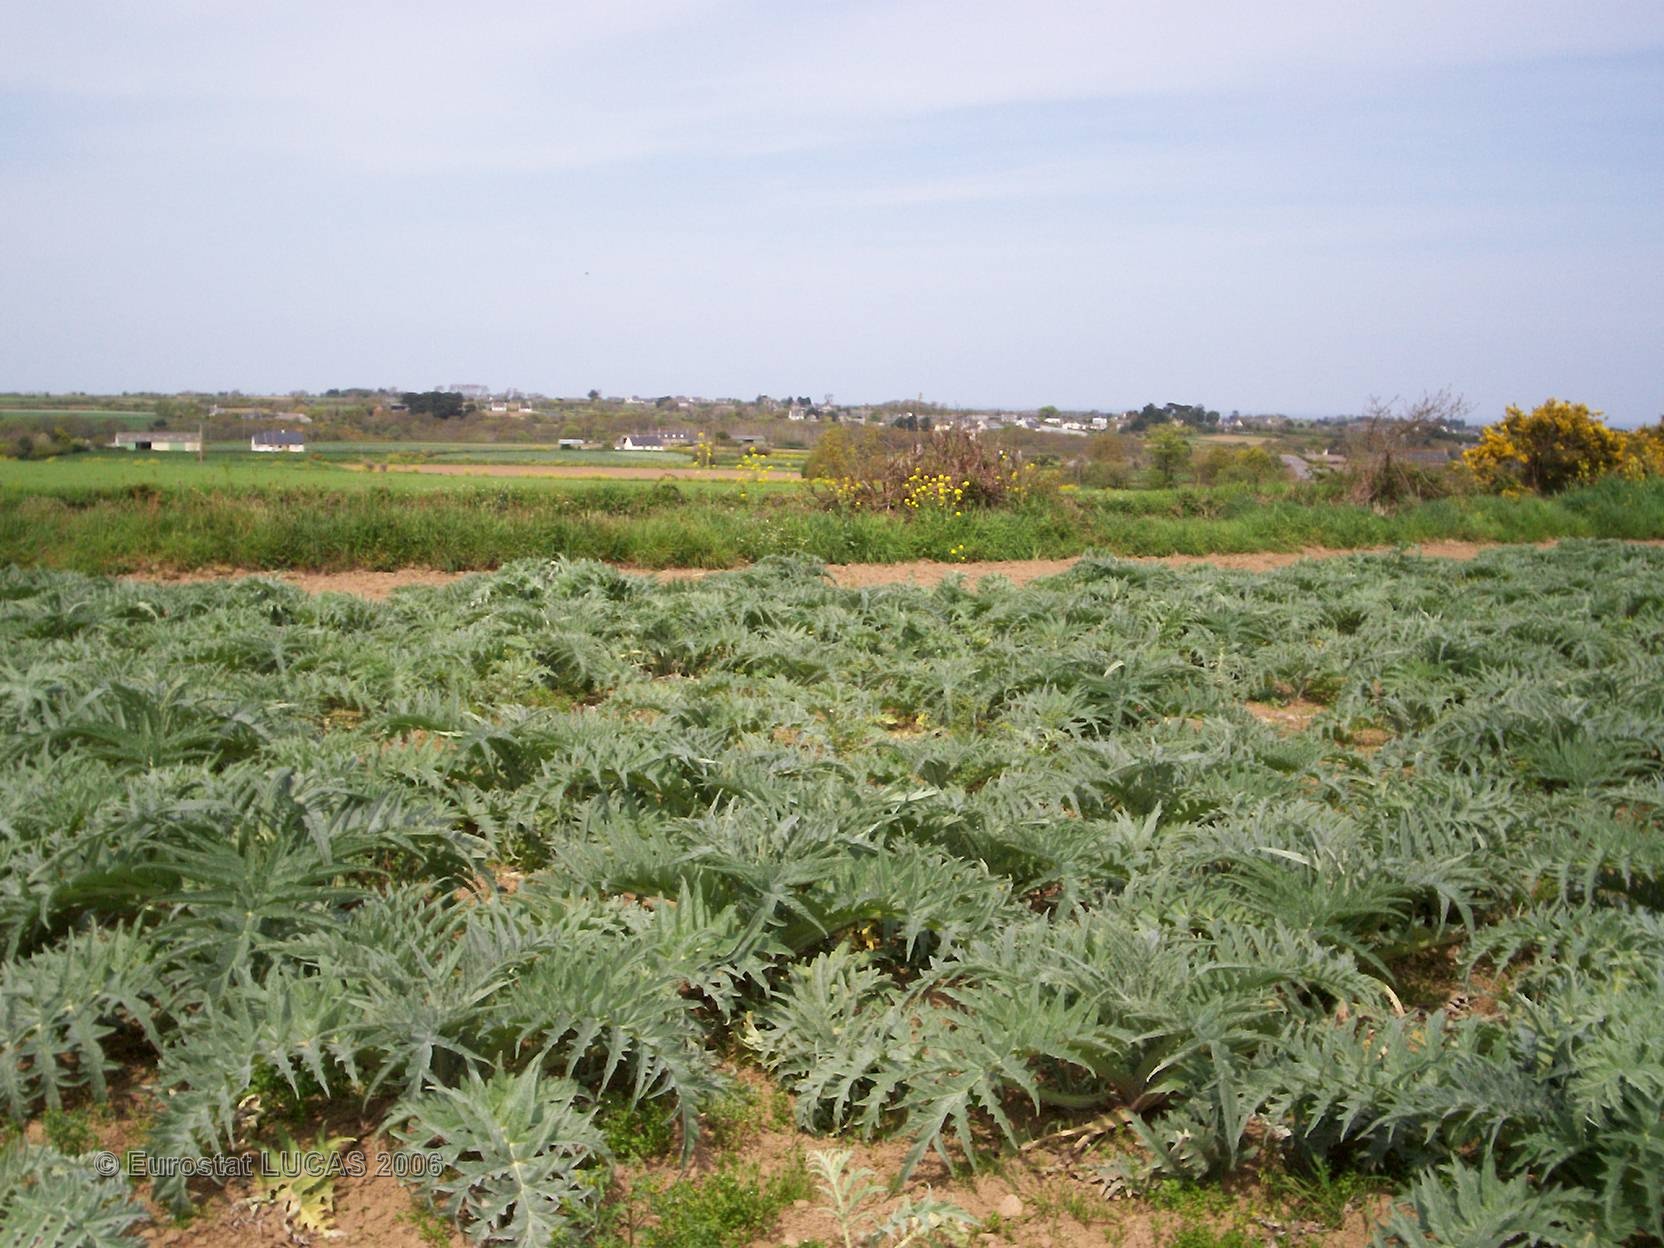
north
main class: Cropland
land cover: Other fresh vegetables
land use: Agriculture (excluding fallow land and kitchen gardens)
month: May
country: FR
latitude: 48.8220
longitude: -3.1076
